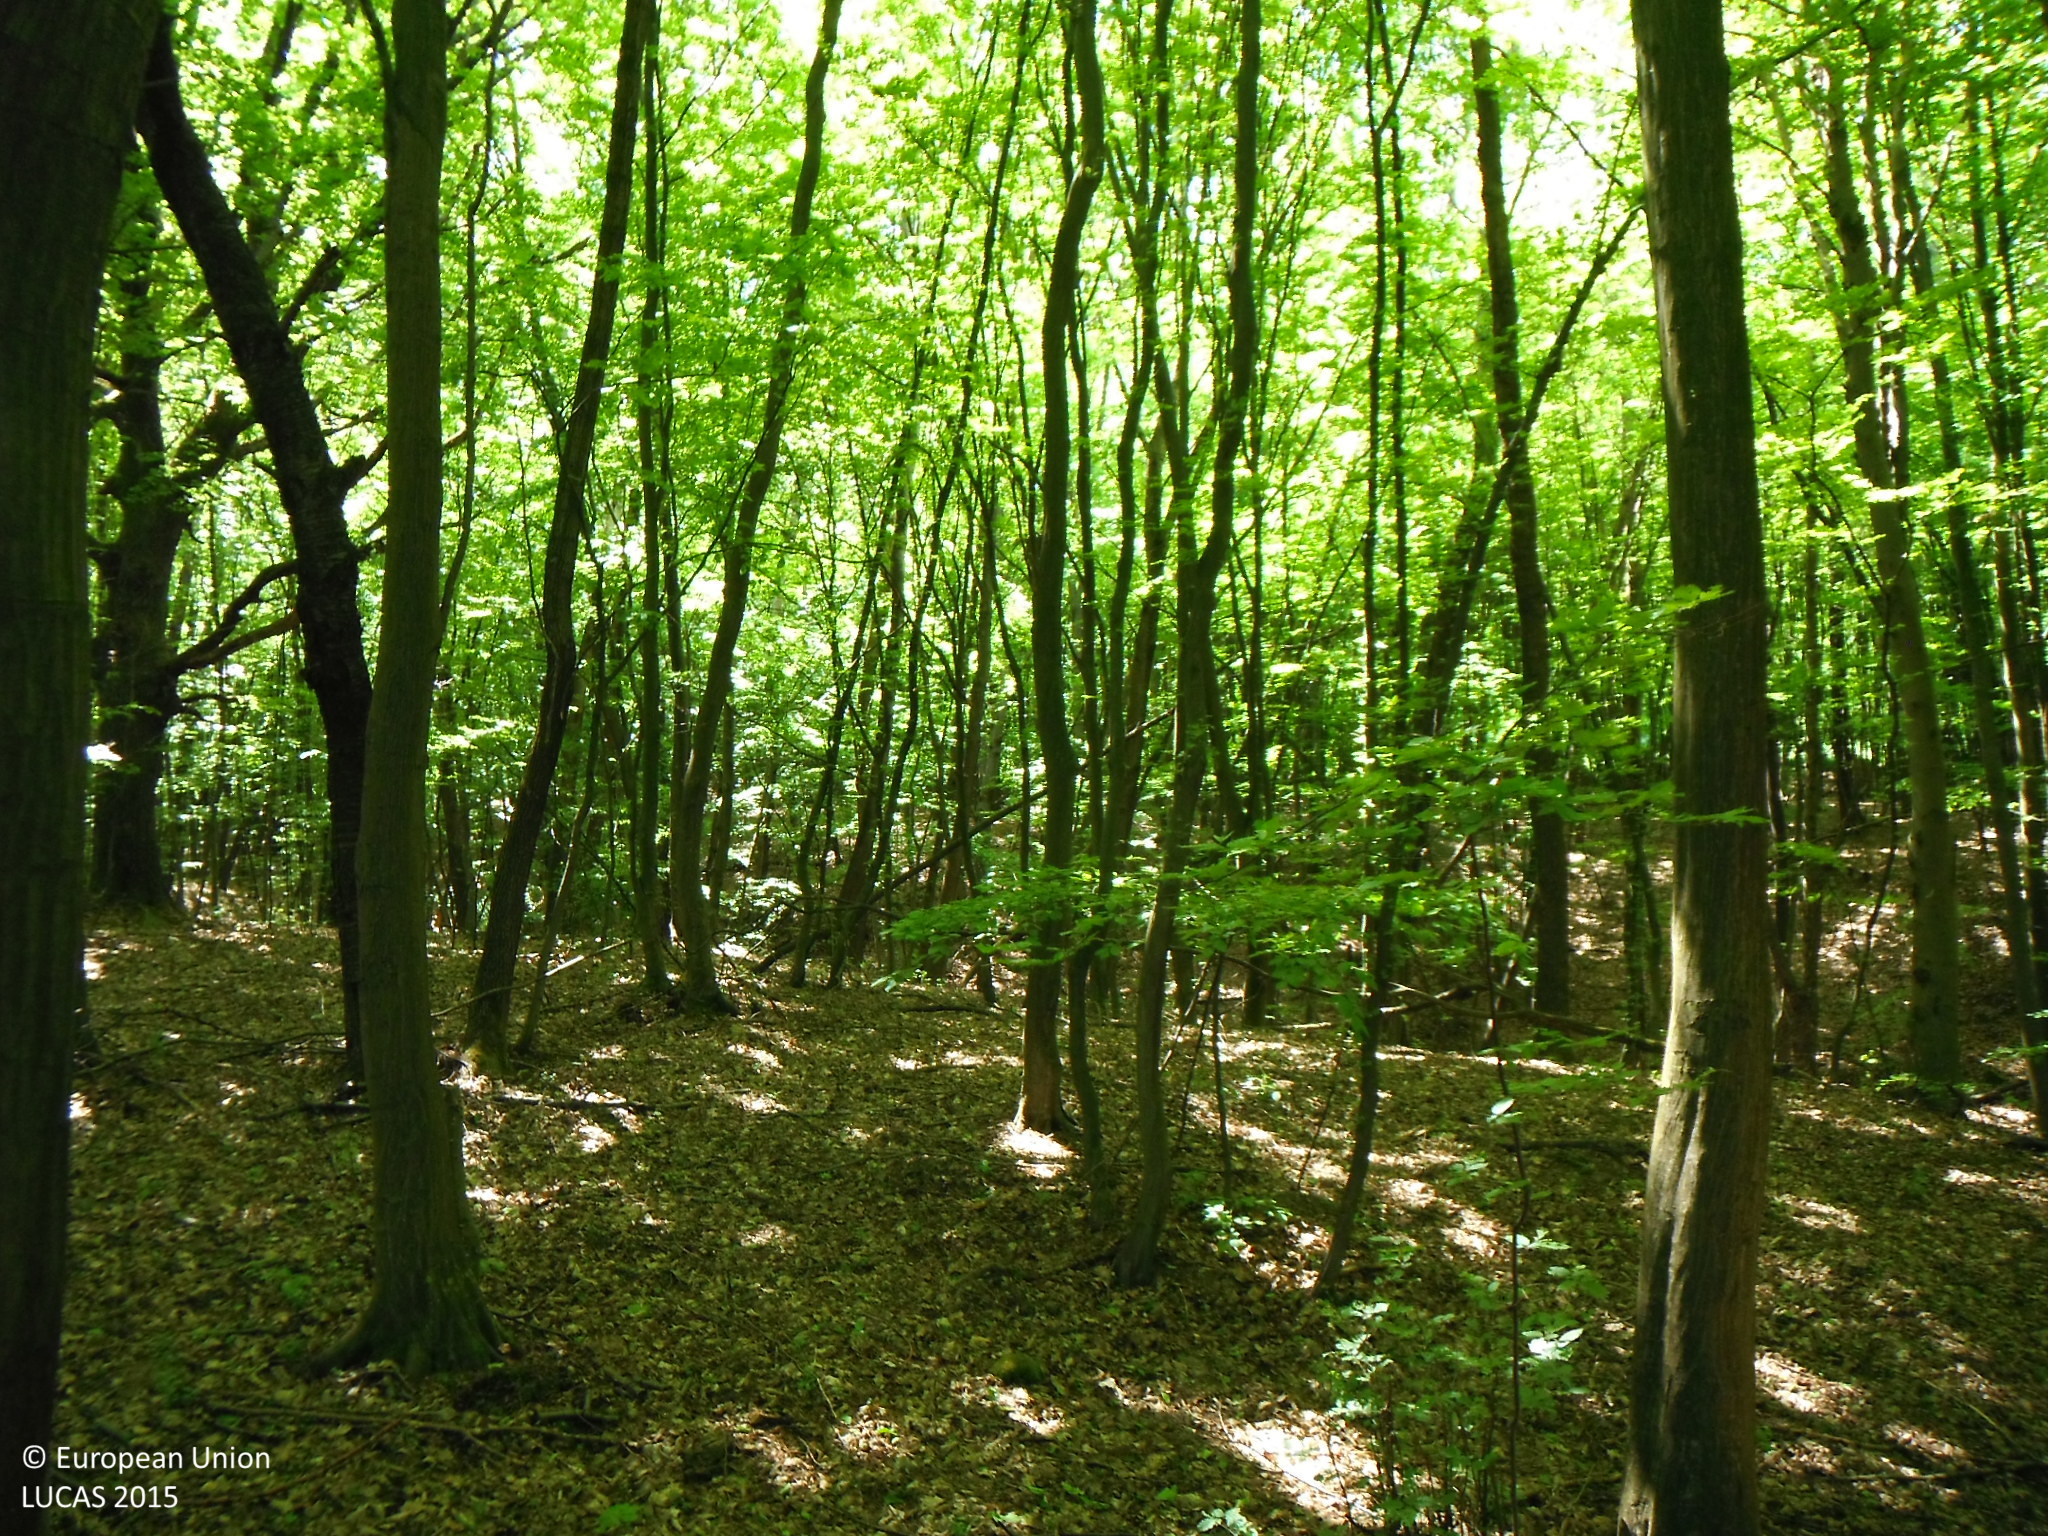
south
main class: Woodland
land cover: Broadleaved woodland
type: mesophytic deciduous forest
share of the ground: > 75 %
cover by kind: broadleaved forest trees 100 %
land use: Forestry
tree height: > 5 m
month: May
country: SK
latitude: 48.5759
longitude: 21.3905
